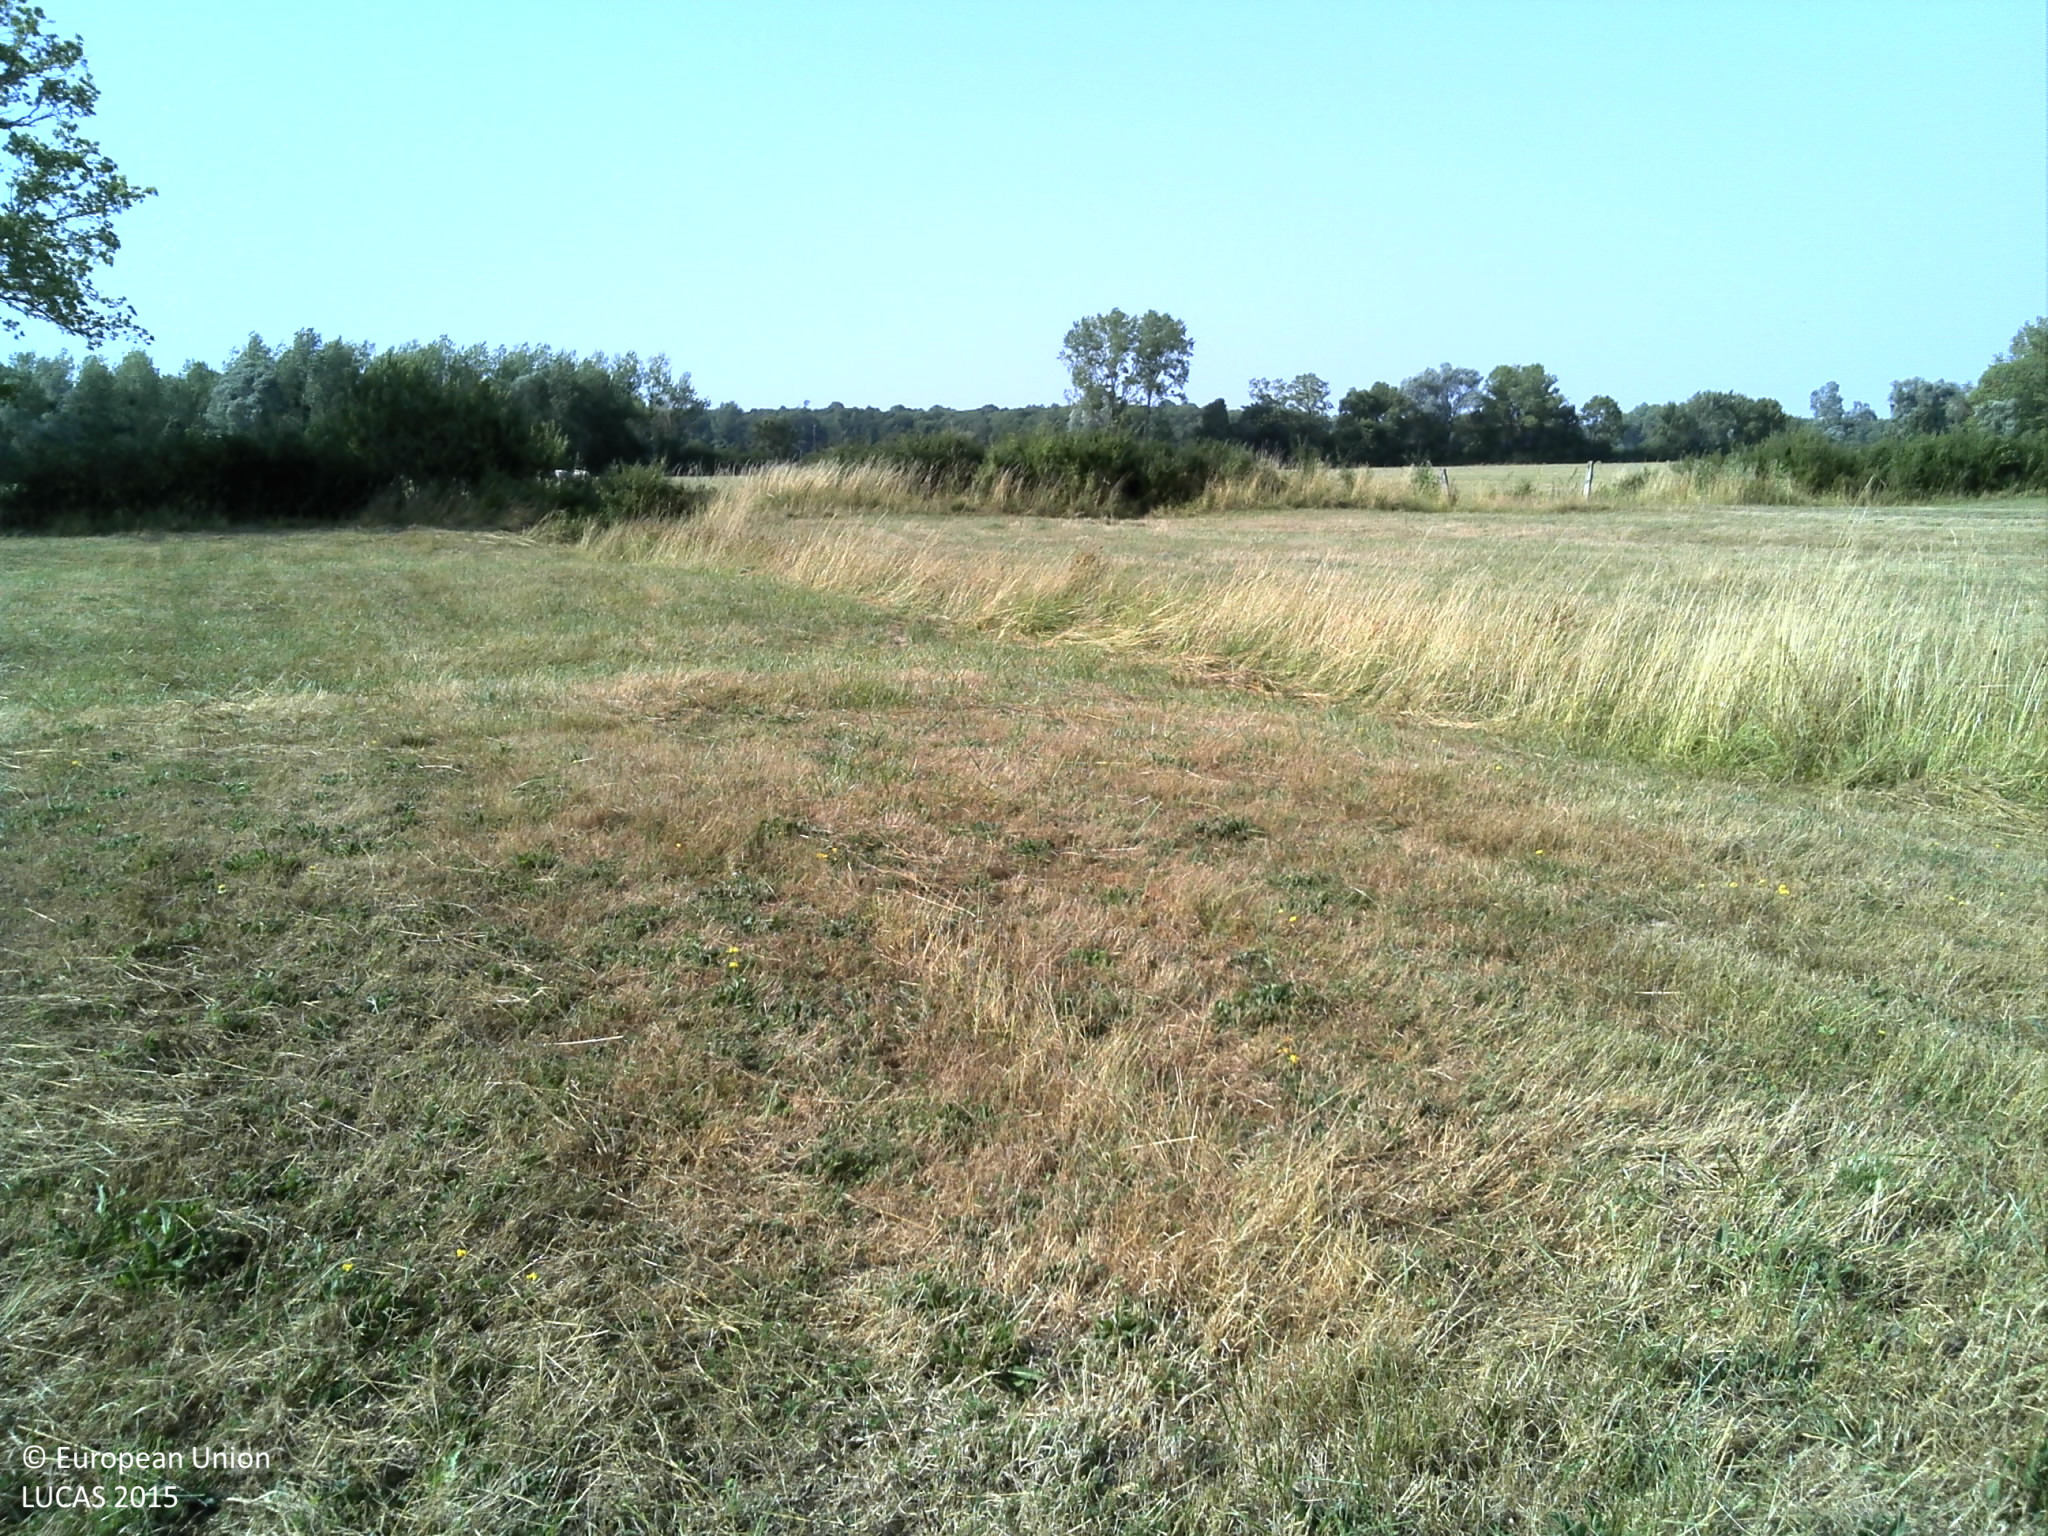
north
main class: Grassland
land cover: Grassland without tree/shrub cover
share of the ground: > 75 %
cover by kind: herbaceous plants 100 %
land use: Agriculture (excluding fallow land and kitchen gardens)
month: July
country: FR
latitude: 48.8224
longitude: 4.8082
